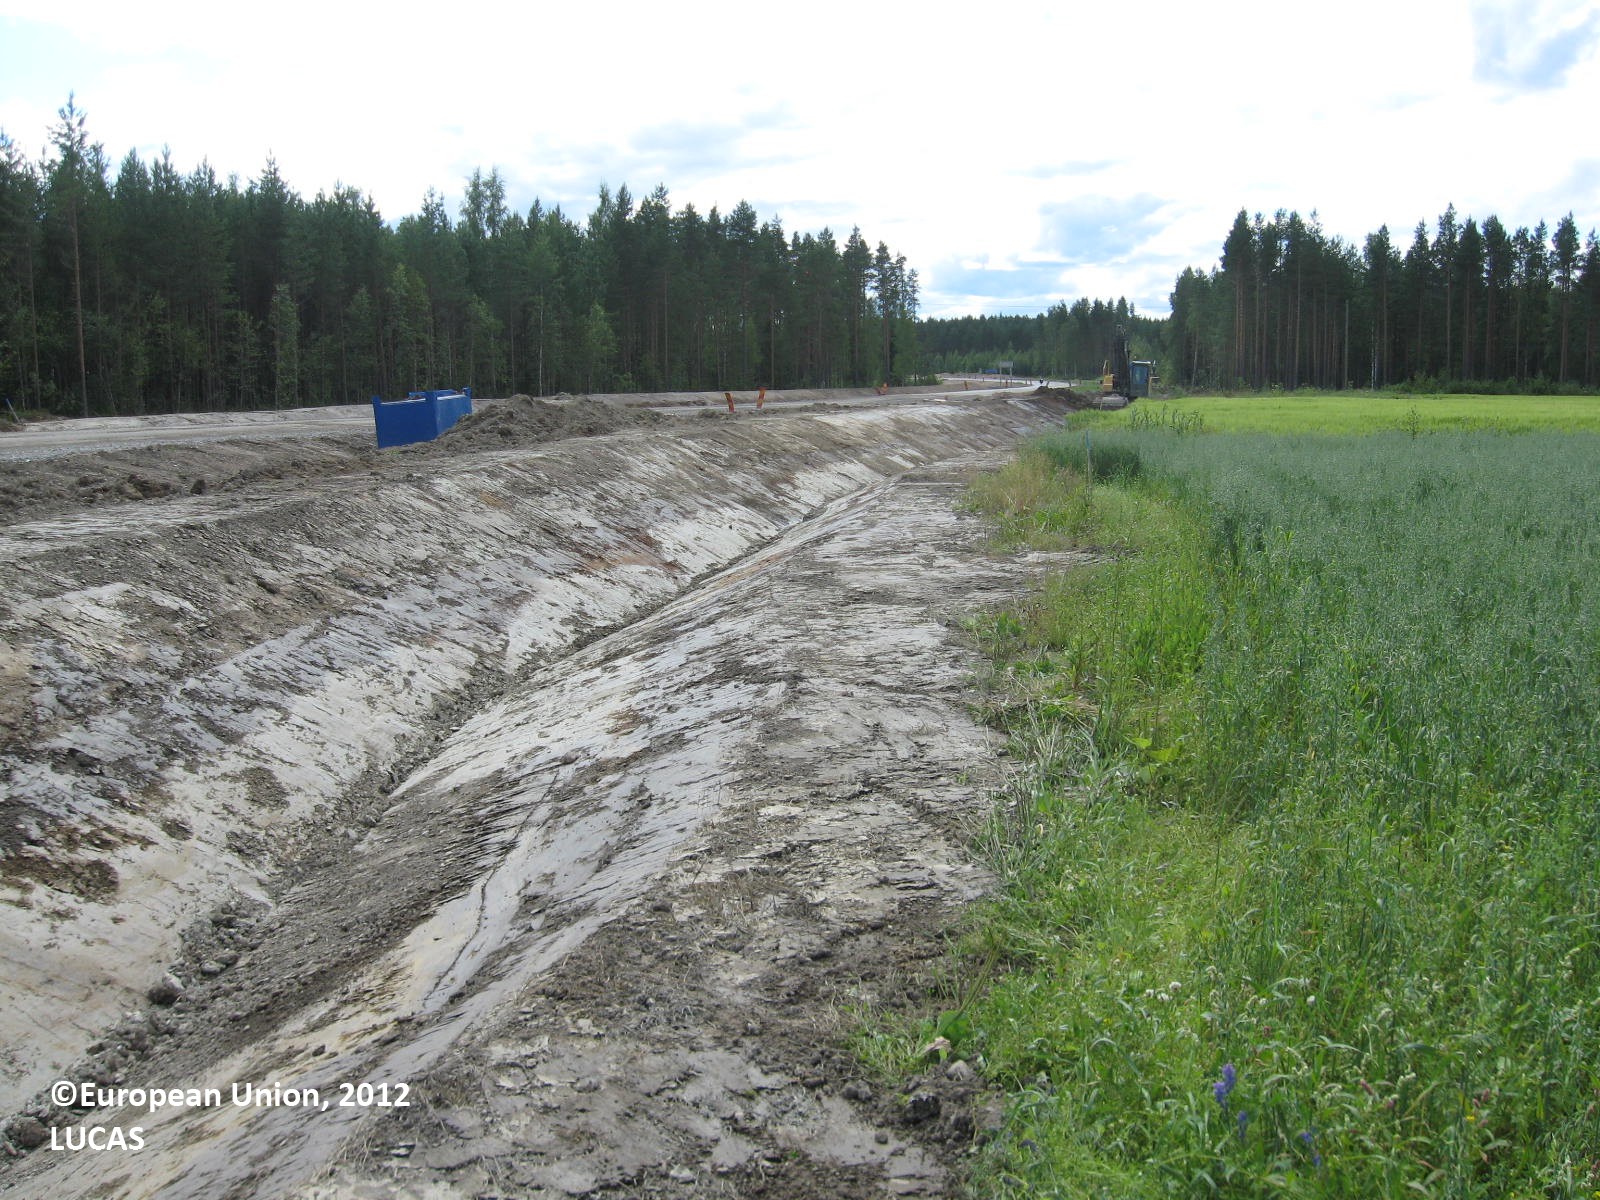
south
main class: Cropland
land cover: Oats
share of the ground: > 75 %
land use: Agriculture (excluding fallow land and kitchen gardens)
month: July
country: FI
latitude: 62.0206
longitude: 22.2267
